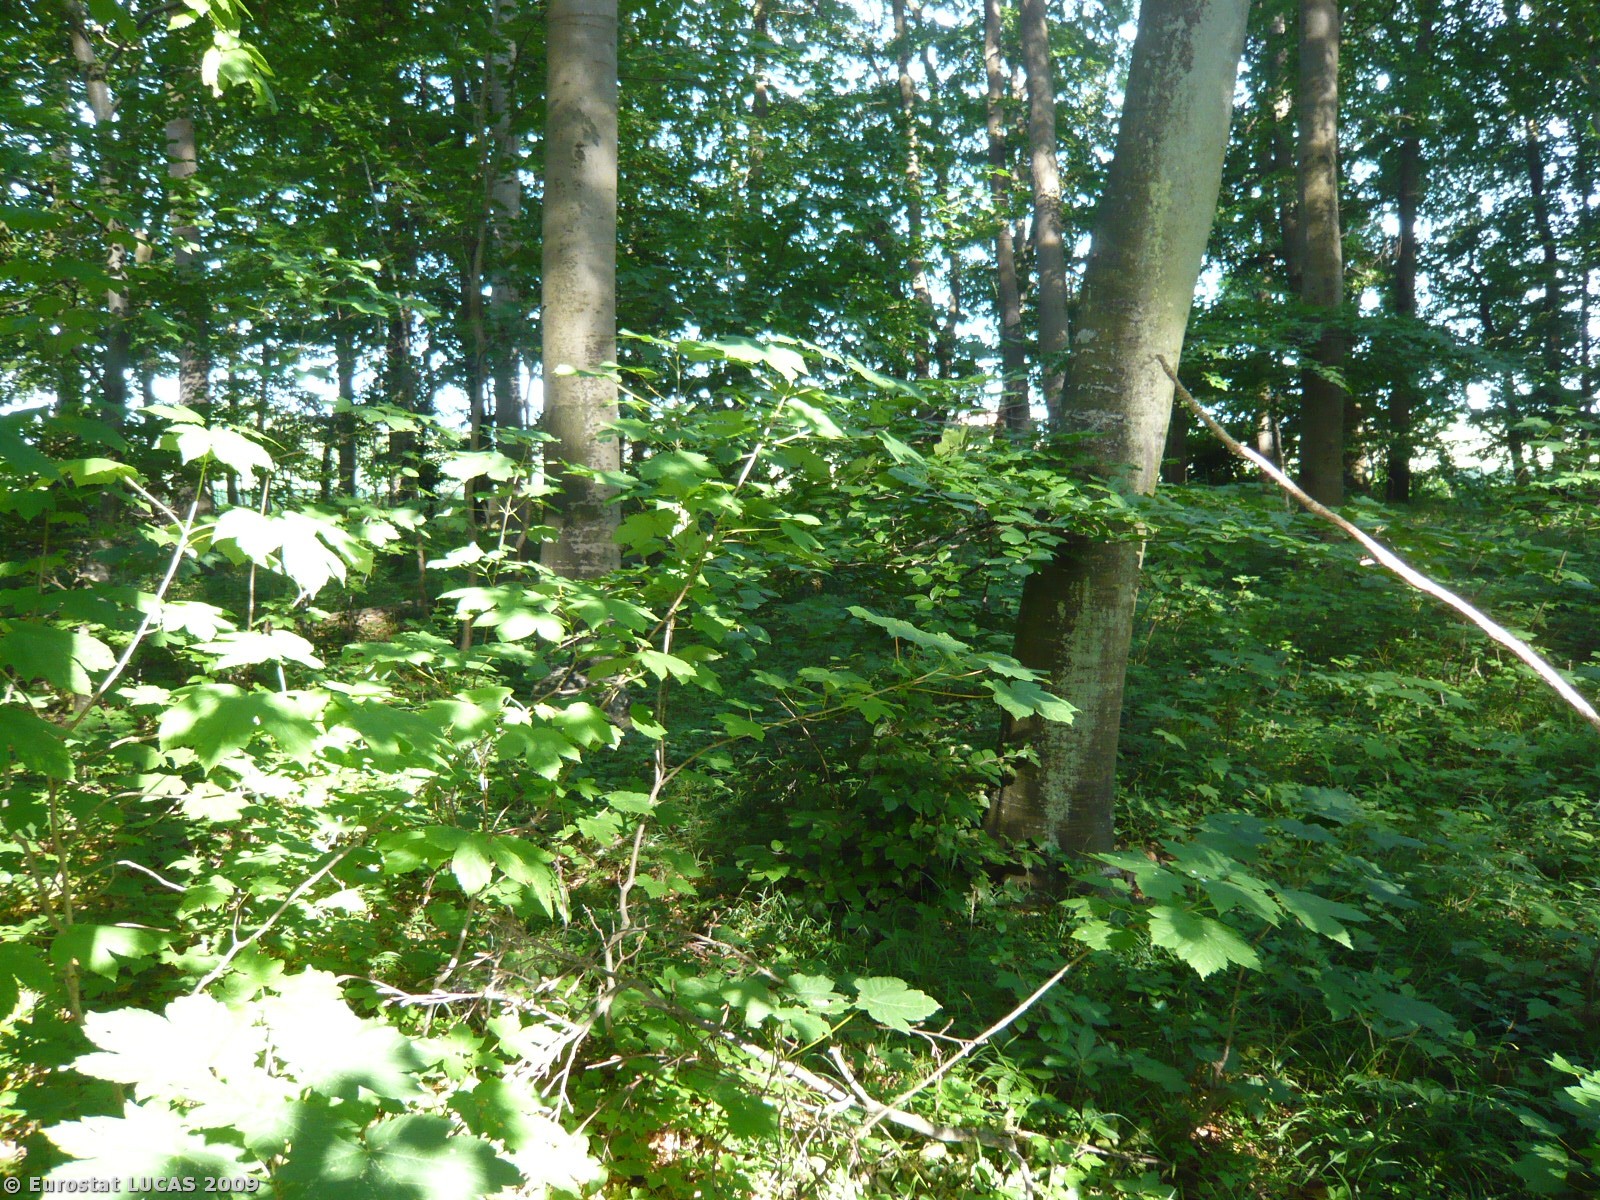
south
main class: Woodland
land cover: Broadleaved woodland
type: mesophytic deciduous forest
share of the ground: > 75 %
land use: Forestry
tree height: > 5 m
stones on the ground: < 10 %
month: June
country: DK
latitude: 54.8327
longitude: 11.3224
